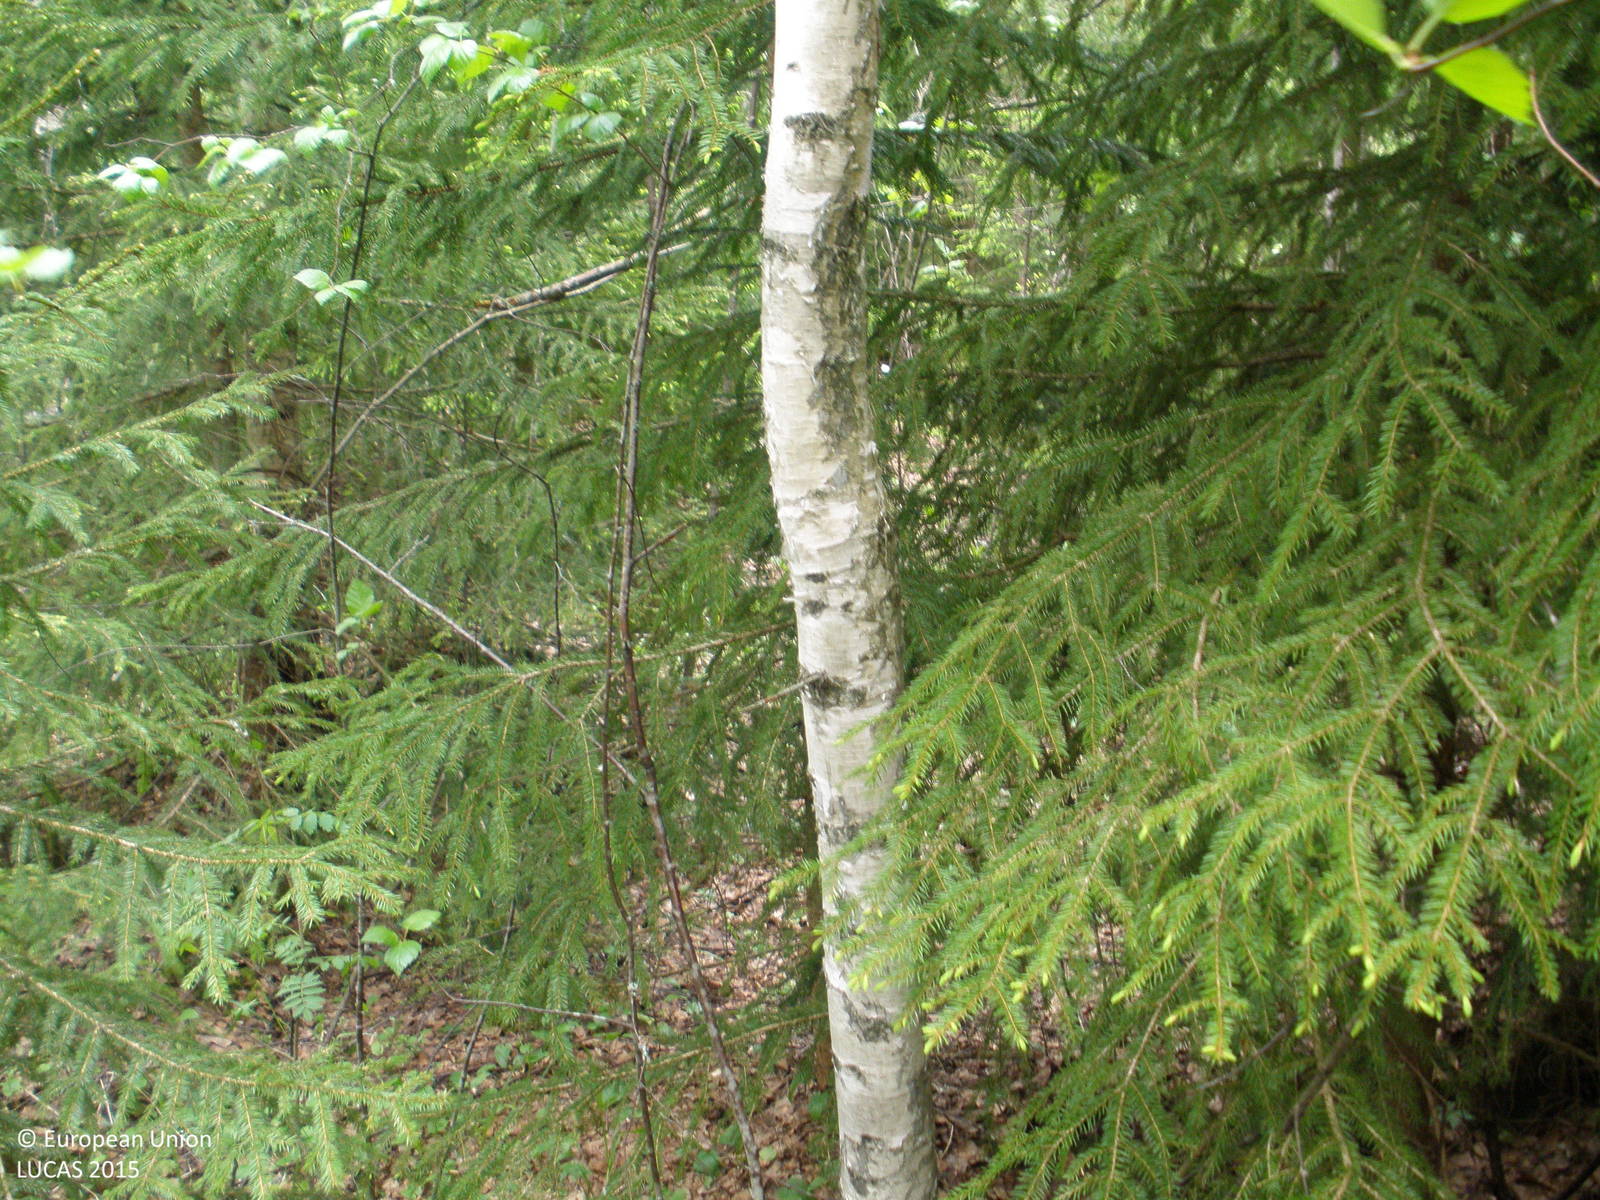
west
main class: Woodland
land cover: Other mixed woodland
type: boreal forest
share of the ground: > 75 %
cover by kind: broadleaved forest trees 70 %, coniferous forest trees 25 %, shrubs 5 %
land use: Forestry
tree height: > 5 m
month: June
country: FI
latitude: 60.5909
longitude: 23.0960
